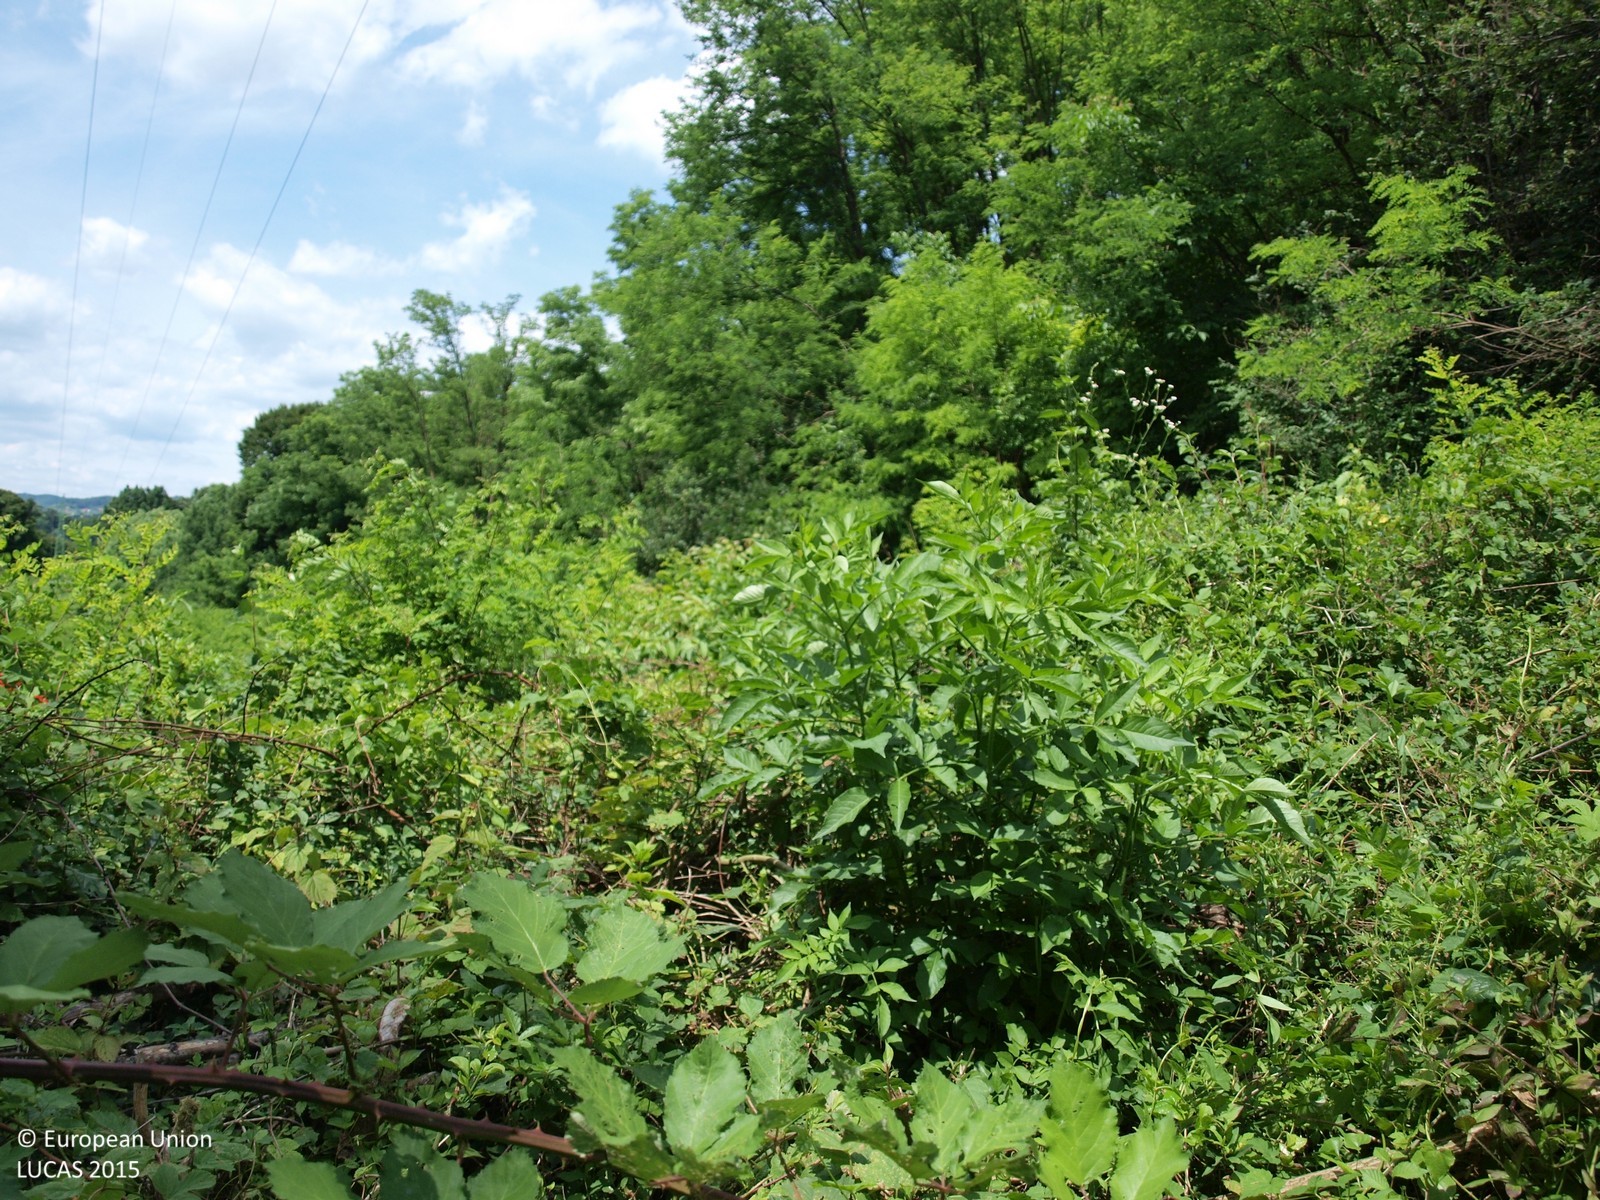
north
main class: Artificial land
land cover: Other artificial areas
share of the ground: 25 - 50 %
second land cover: Shrubland without tree cover
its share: > 75 %
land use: Electricity, gas and thermal power distribution
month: June
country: HR
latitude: 46.1253
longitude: 15.7314
